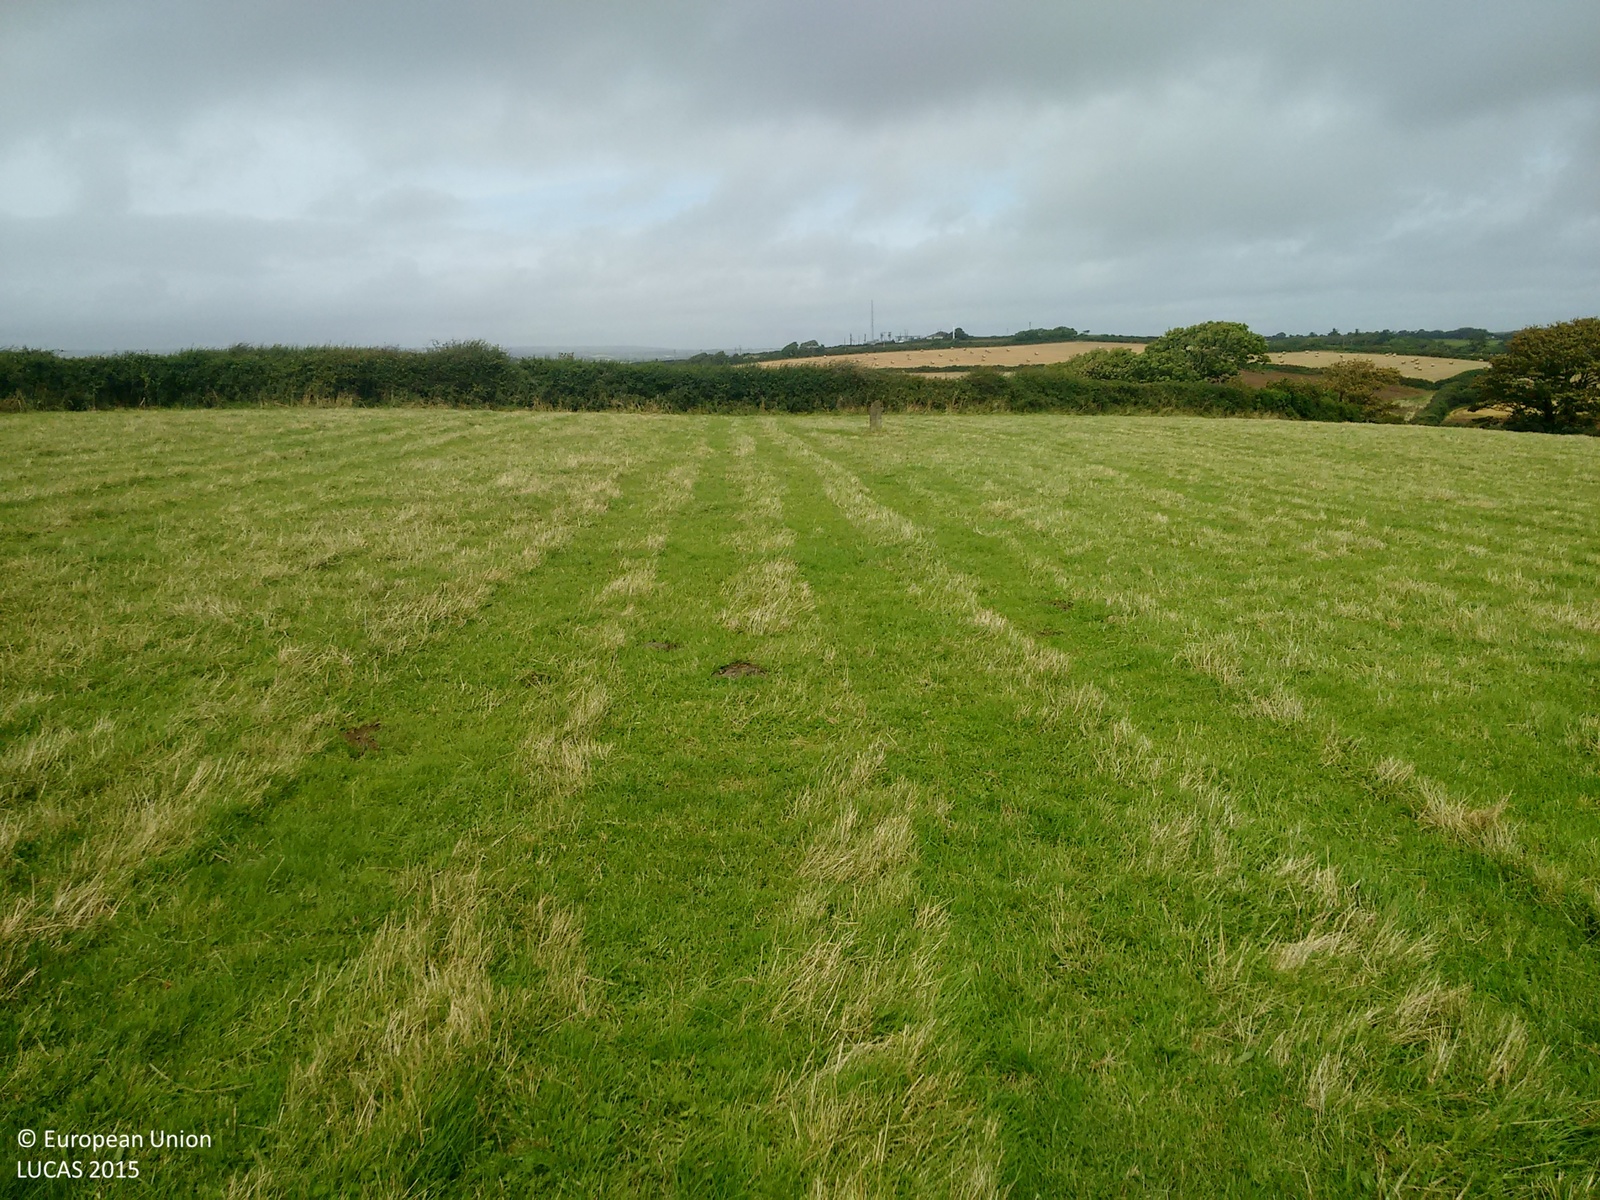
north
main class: Grassland
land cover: Grassland without tree/shrub cover
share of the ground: > 75 %
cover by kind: herbaceous plants 100 %
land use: Agriculture (excluding fallow land and kitchen gardens)
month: August
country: GB
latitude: 50.0452
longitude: -5.1298
